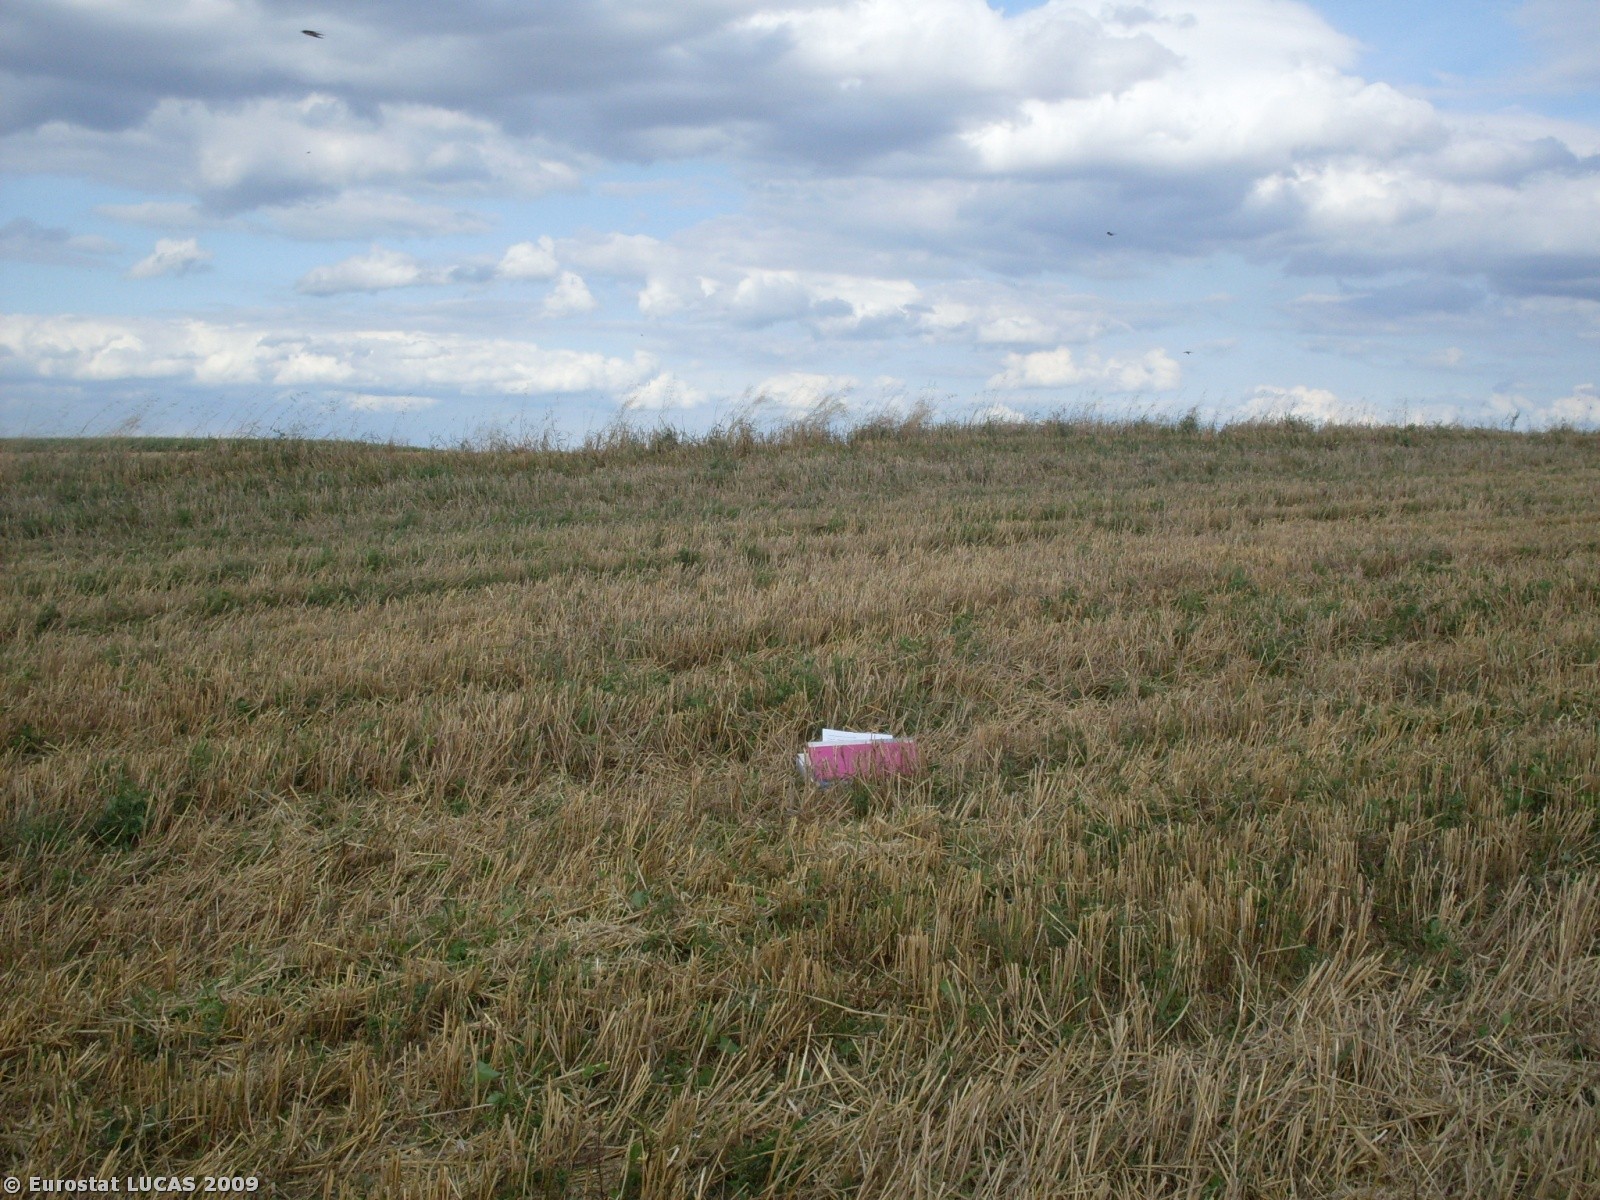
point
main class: Cropland
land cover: Barley
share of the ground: < 10 %
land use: Agriculture (excluding fallow land and kitchen gardens)
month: August
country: PL
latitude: 52.9377
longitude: 15.4344
